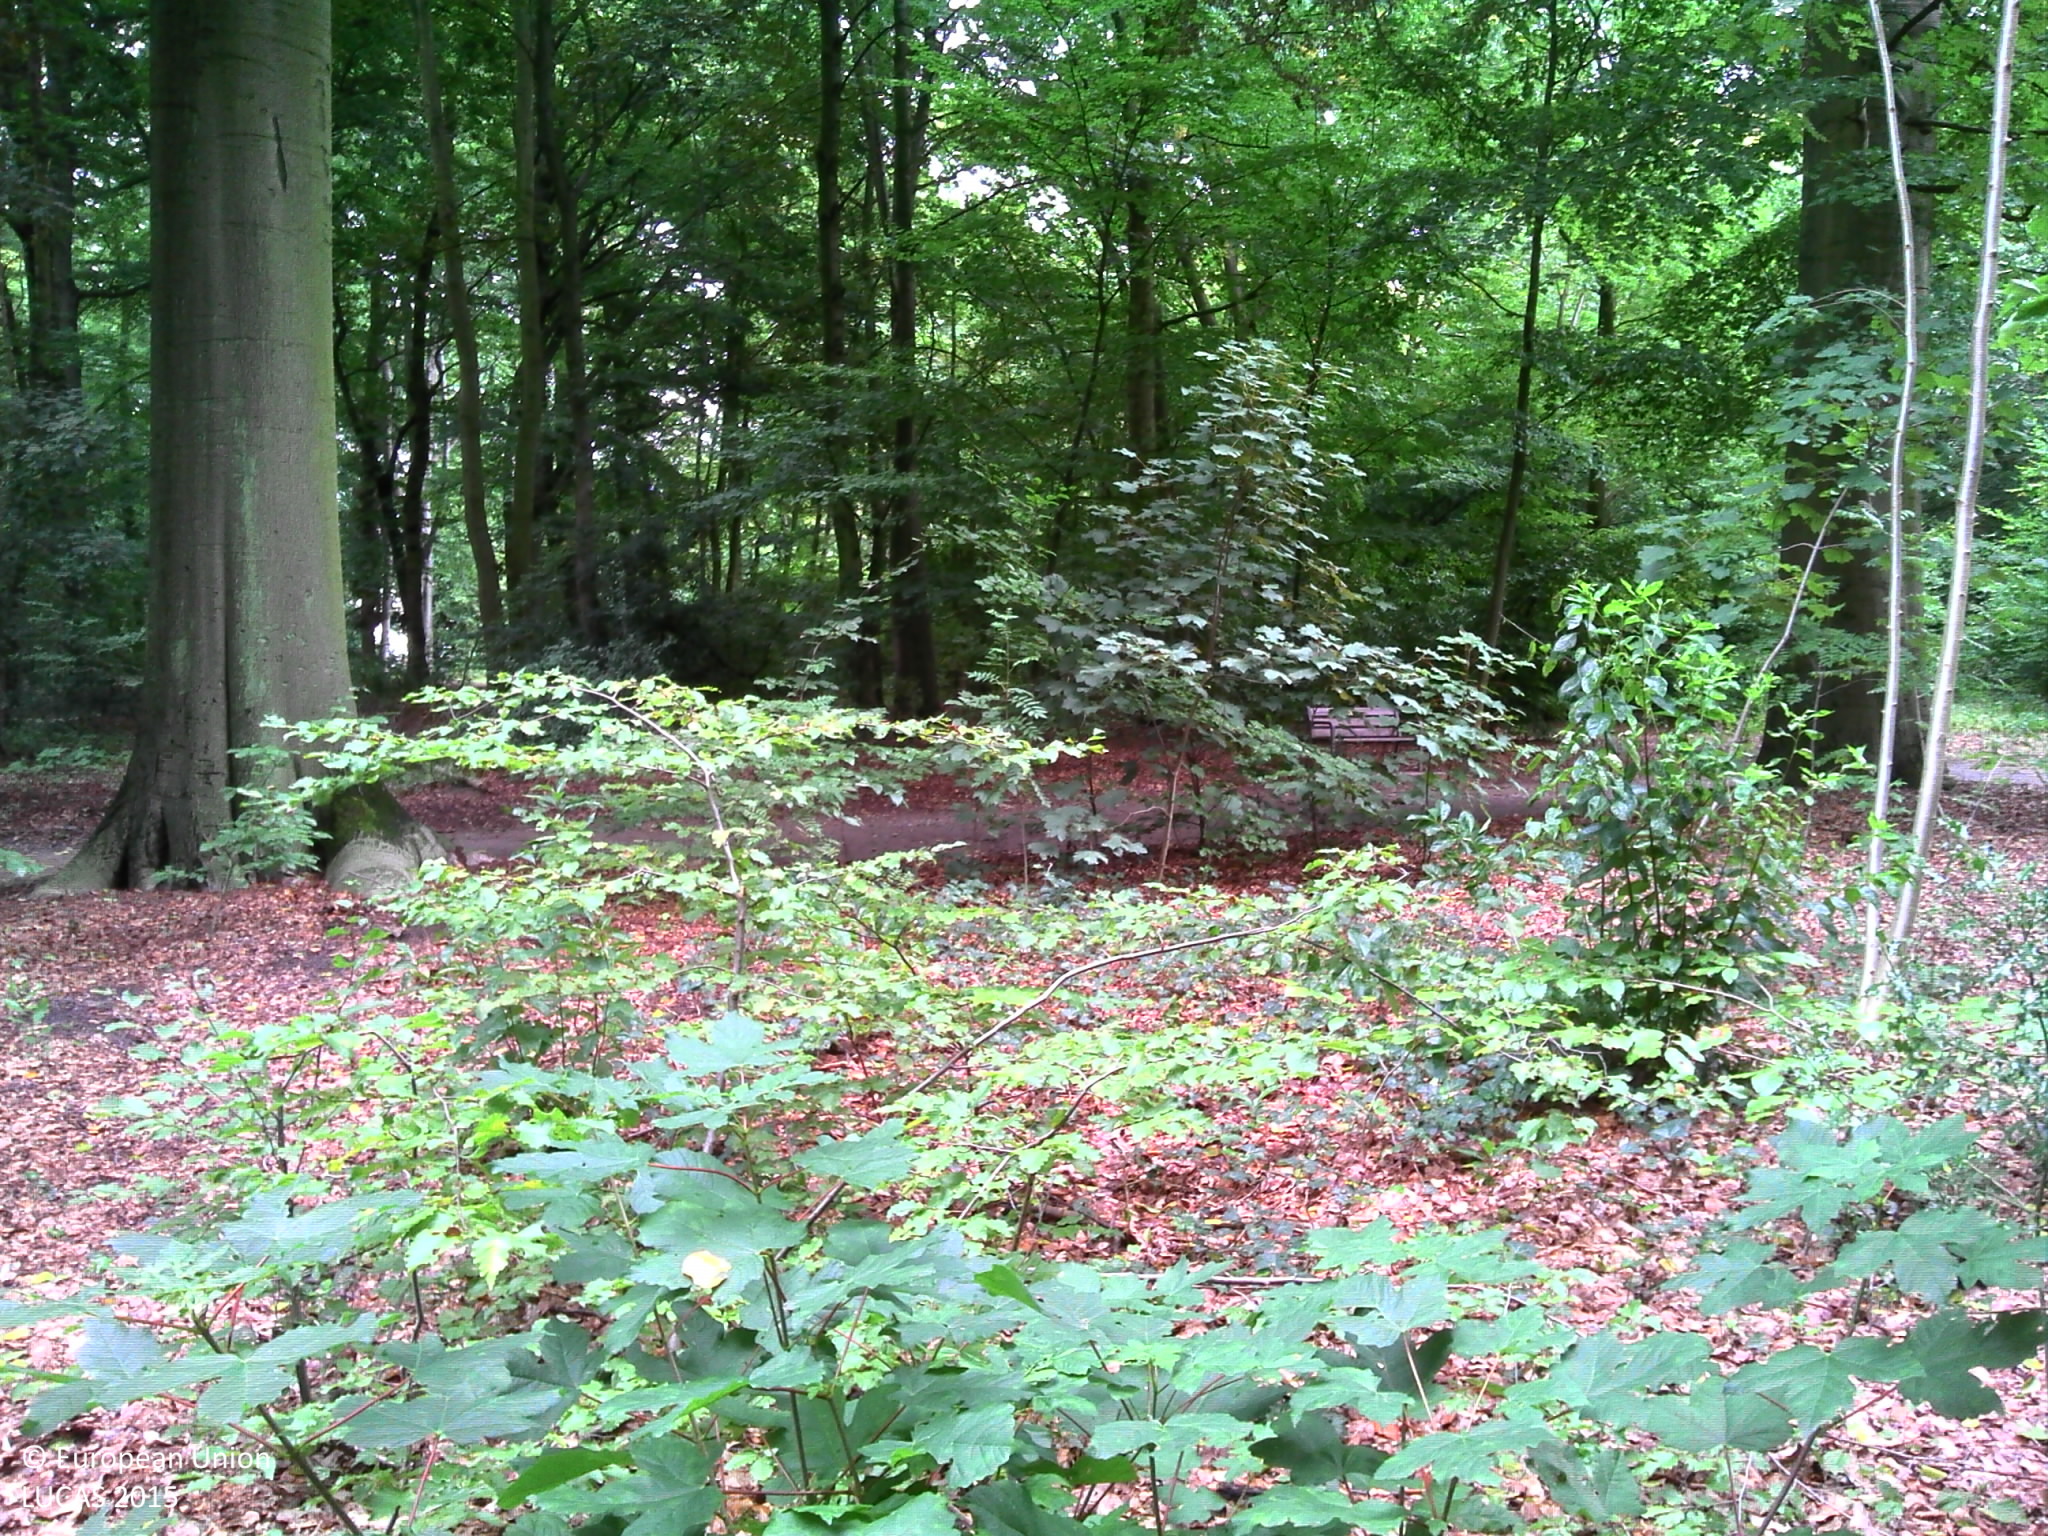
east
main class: Woodland
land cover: Broadleaved woodland
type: beech forest
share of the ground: 50 - 75 %
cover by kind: broadleaved forest trees 60 %, shrubs 20 %, unconsolidated bare surface 20 %
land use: Amenities, museums, leisure
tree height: > 5 m
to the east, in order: Broadleaved woodland; Lines of trees; Tracks; Lines of trees; Broadleaved woodland; Lines of trees; Grass margins; Tracks; Grass margins; Lines of trees; Broadleaved woodland; Lines of trees; Tracks; Lines of trees; Broadleaved woodland; Inland fresh running water; Broadleaved woodland; Grass margins; Tracks; Broadleaved woodland; Grassland without tree/shrub cover
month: September
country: BE
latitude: 51.1822
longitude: 4.4018
